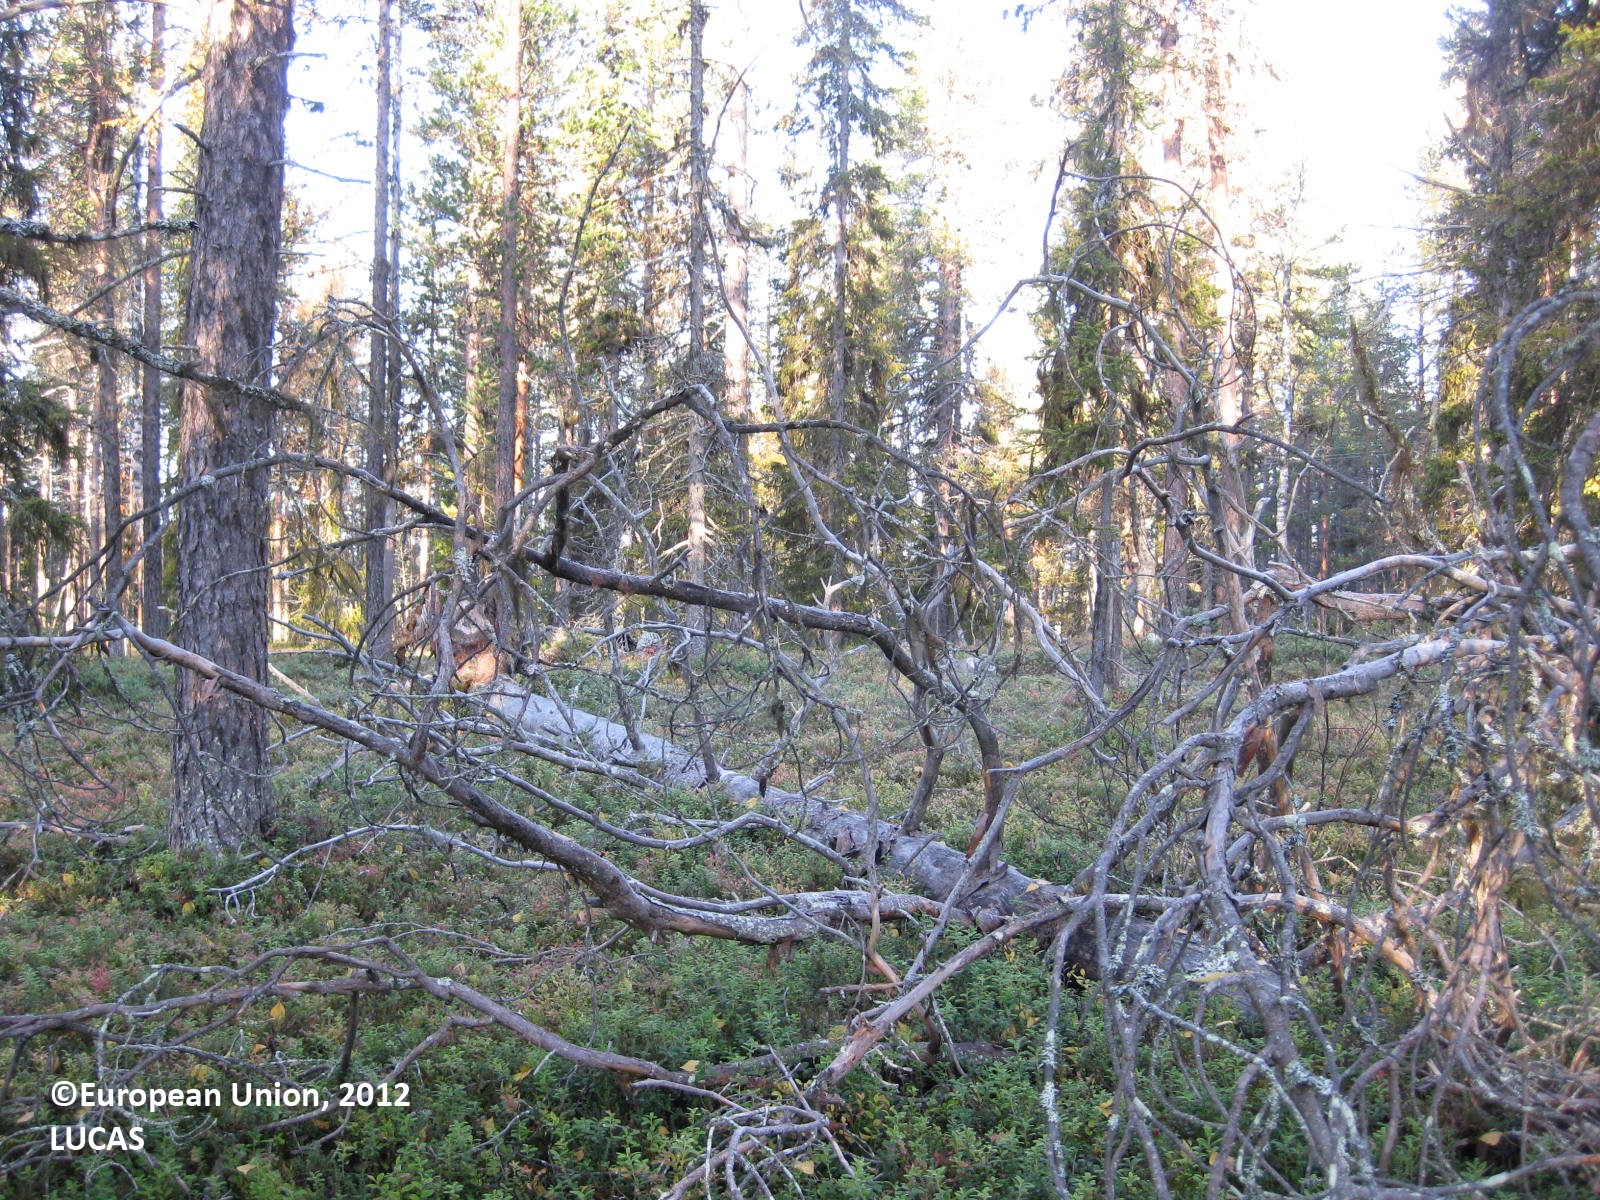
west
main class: Woodland
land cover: Other coniferous woodland
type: boreal forest
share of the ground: > 75 %
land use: Semi-natural and natural areas not in use
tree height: > 5 m
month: September
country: FI
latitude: 67.9583
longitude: 24.0332
